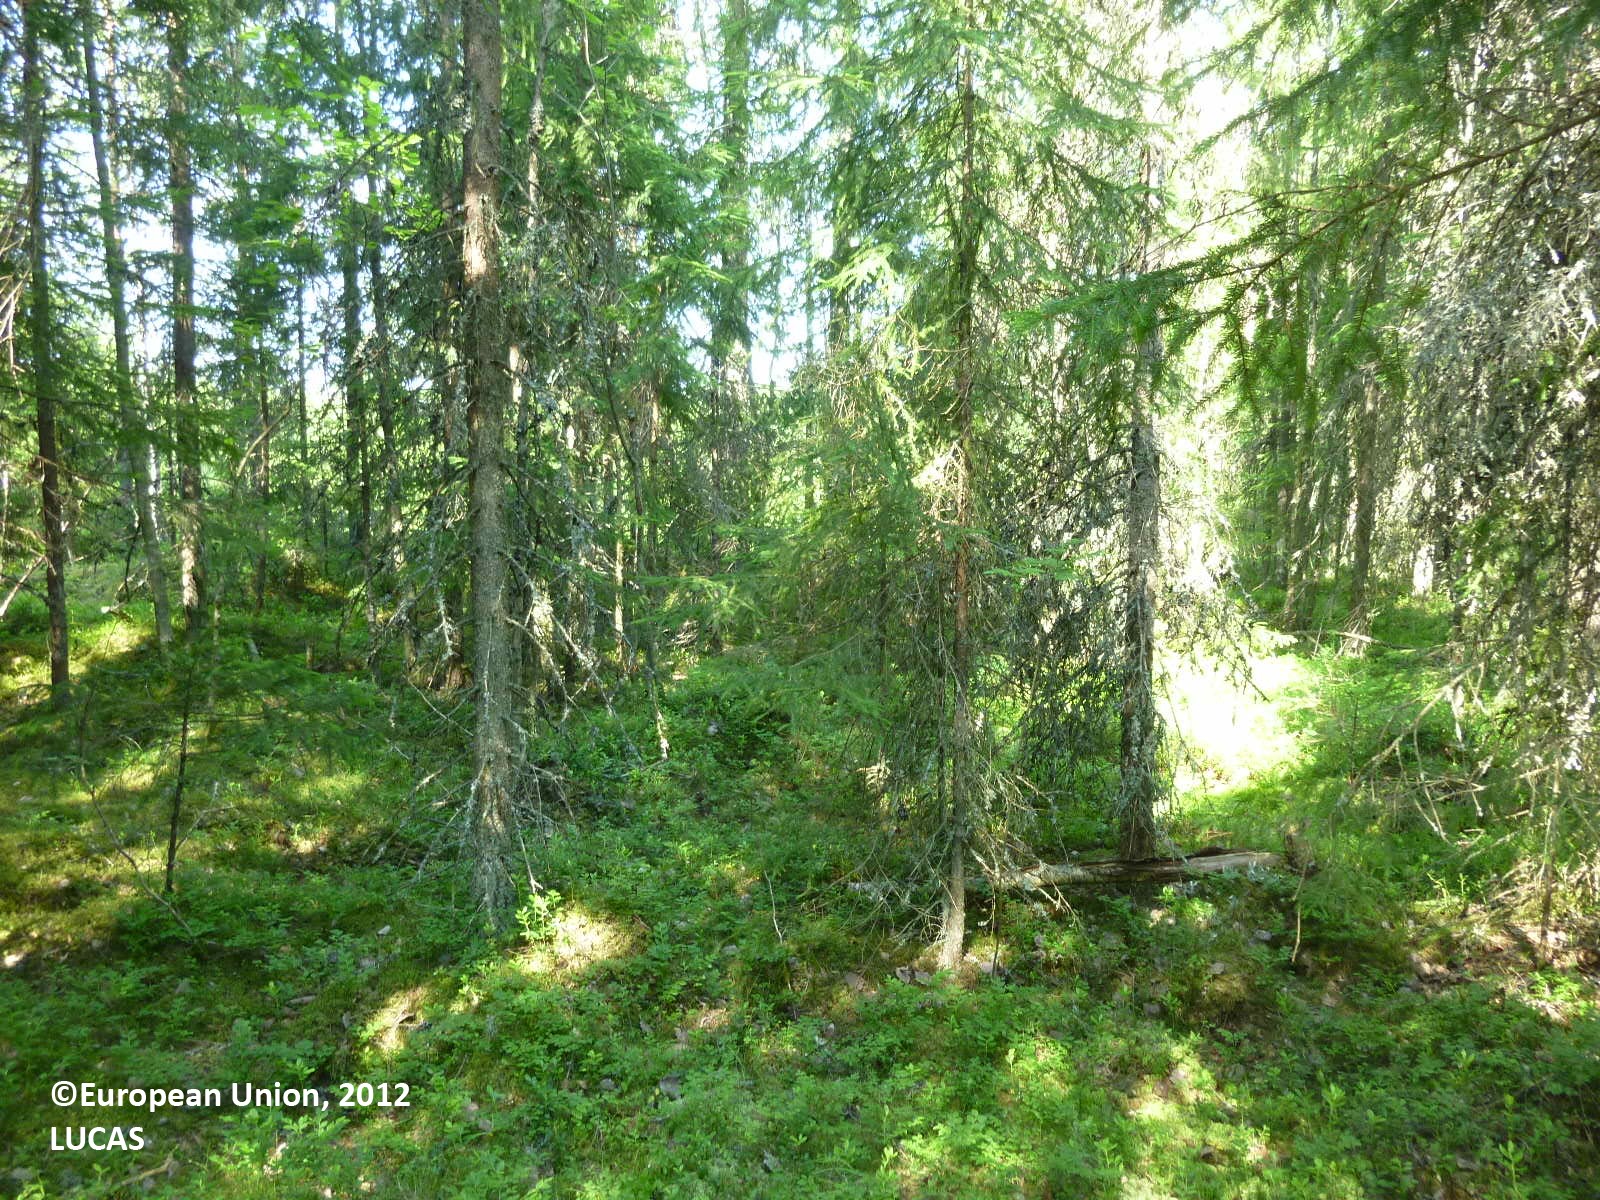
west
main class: Woodland
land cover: Spruce dominated coniferous woodland
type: boreal forest
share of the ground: > 75 %
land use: Forestry
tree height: > 5 m
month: July
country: FI
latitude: 61.1326
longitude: 22.5634
